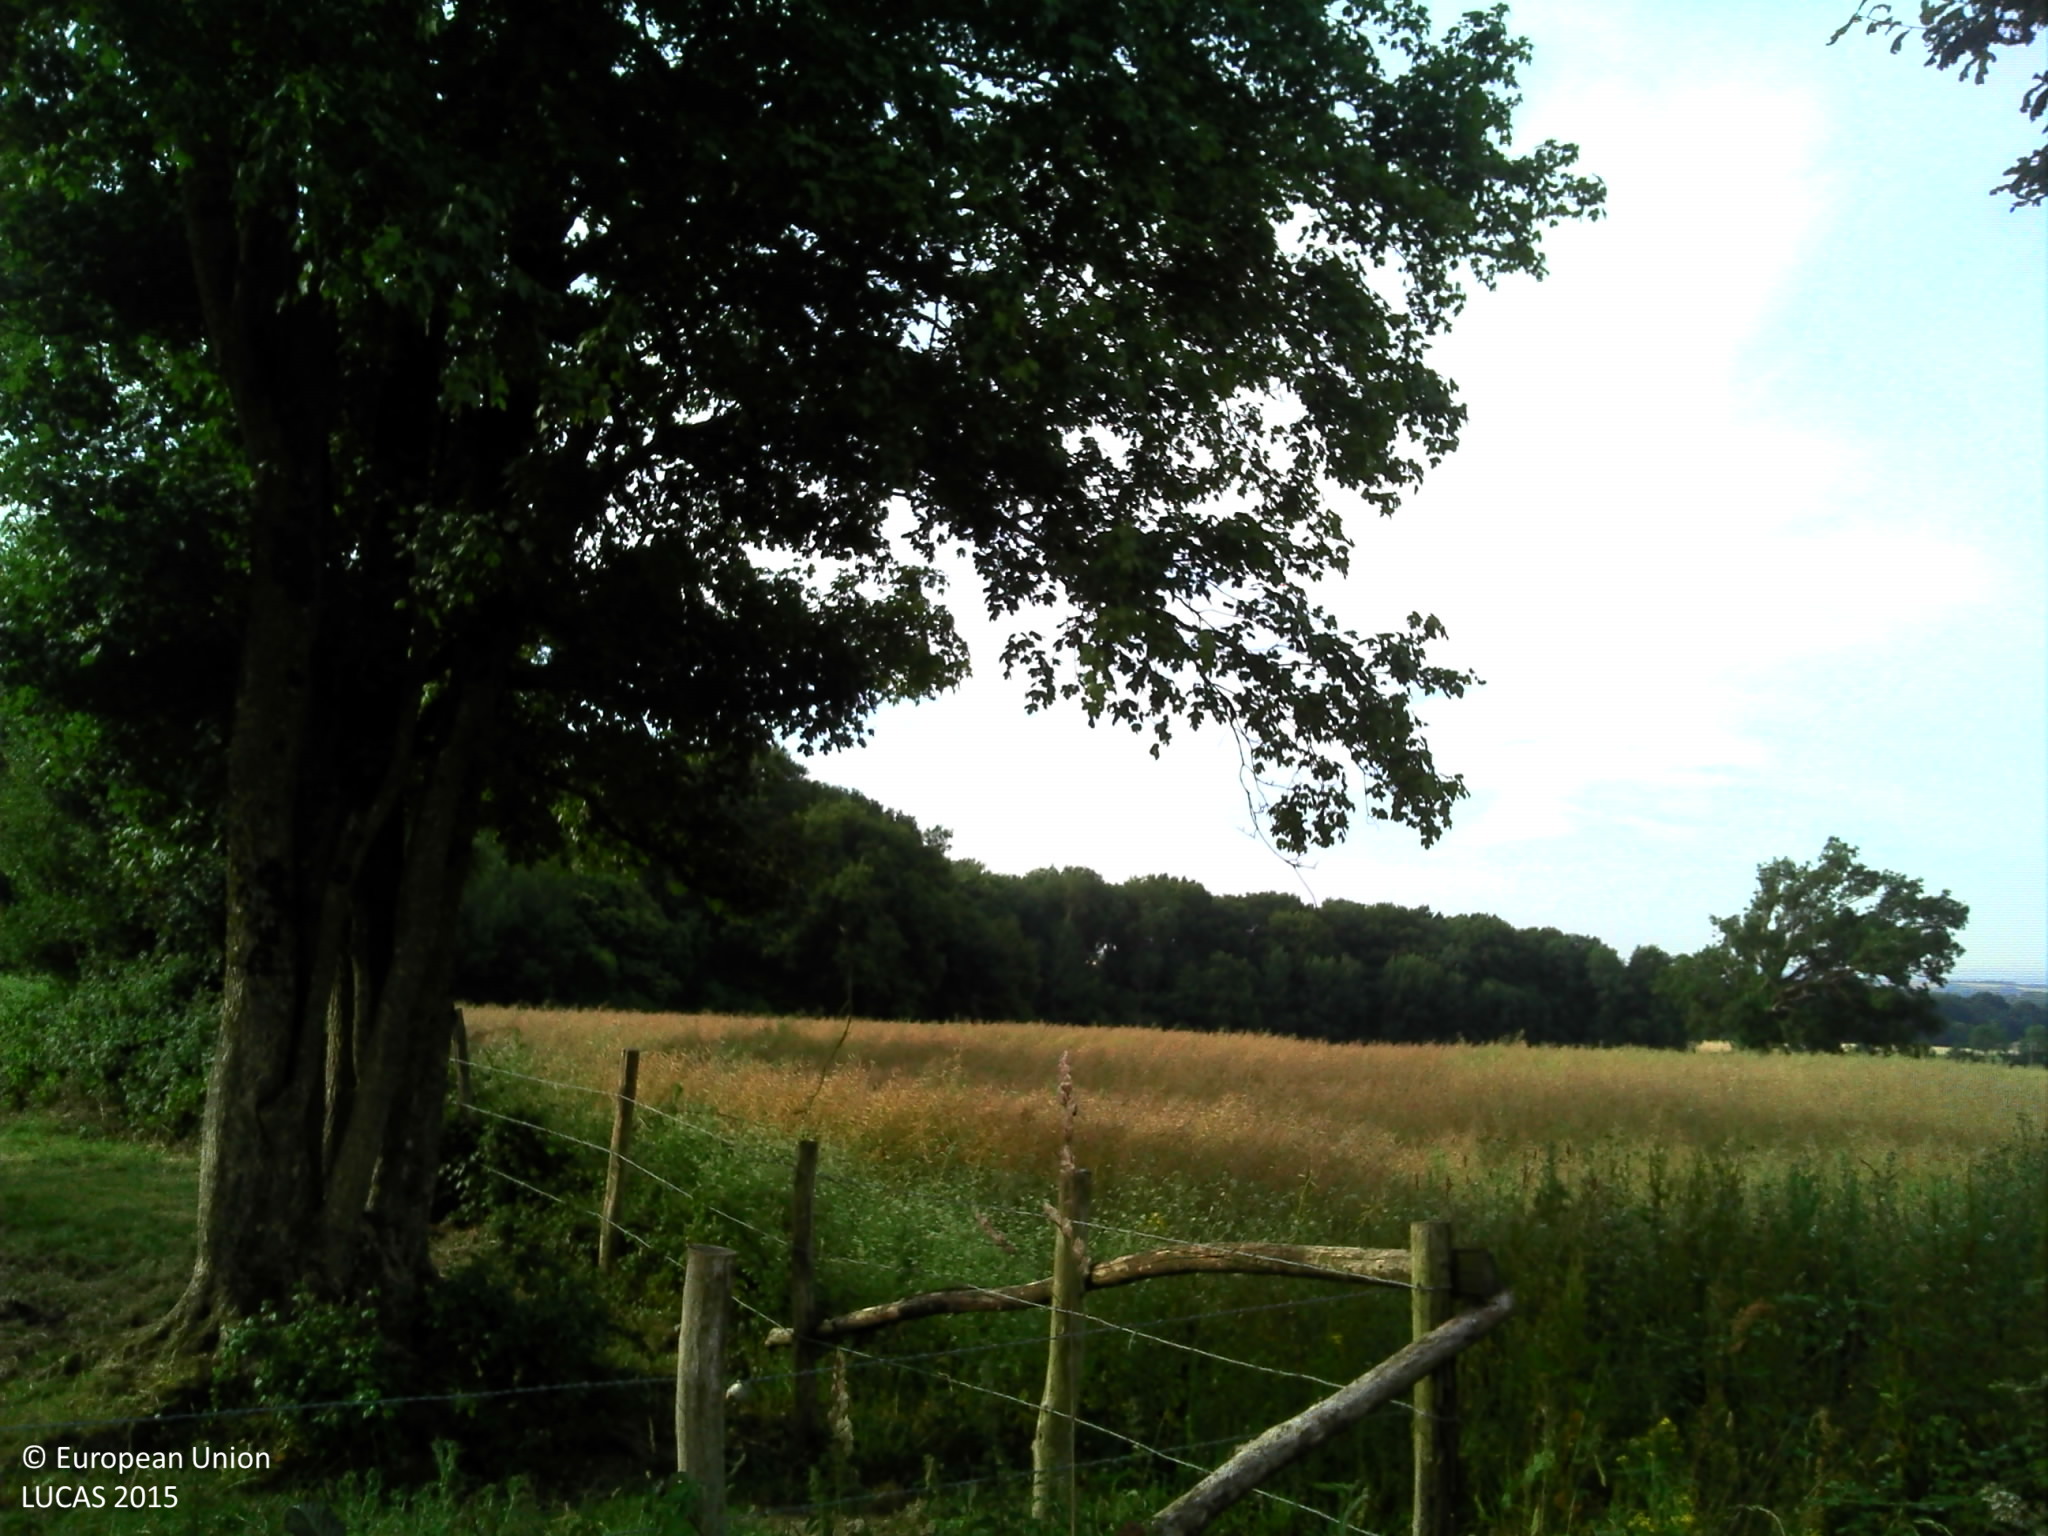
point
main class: Cropland
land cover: Rape and turnip rape
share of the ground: > 75 %
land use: Agriculture (excluding fallow land and kitchen gardens)
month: June
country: FR
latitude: 48.3623
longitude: 0.1599
